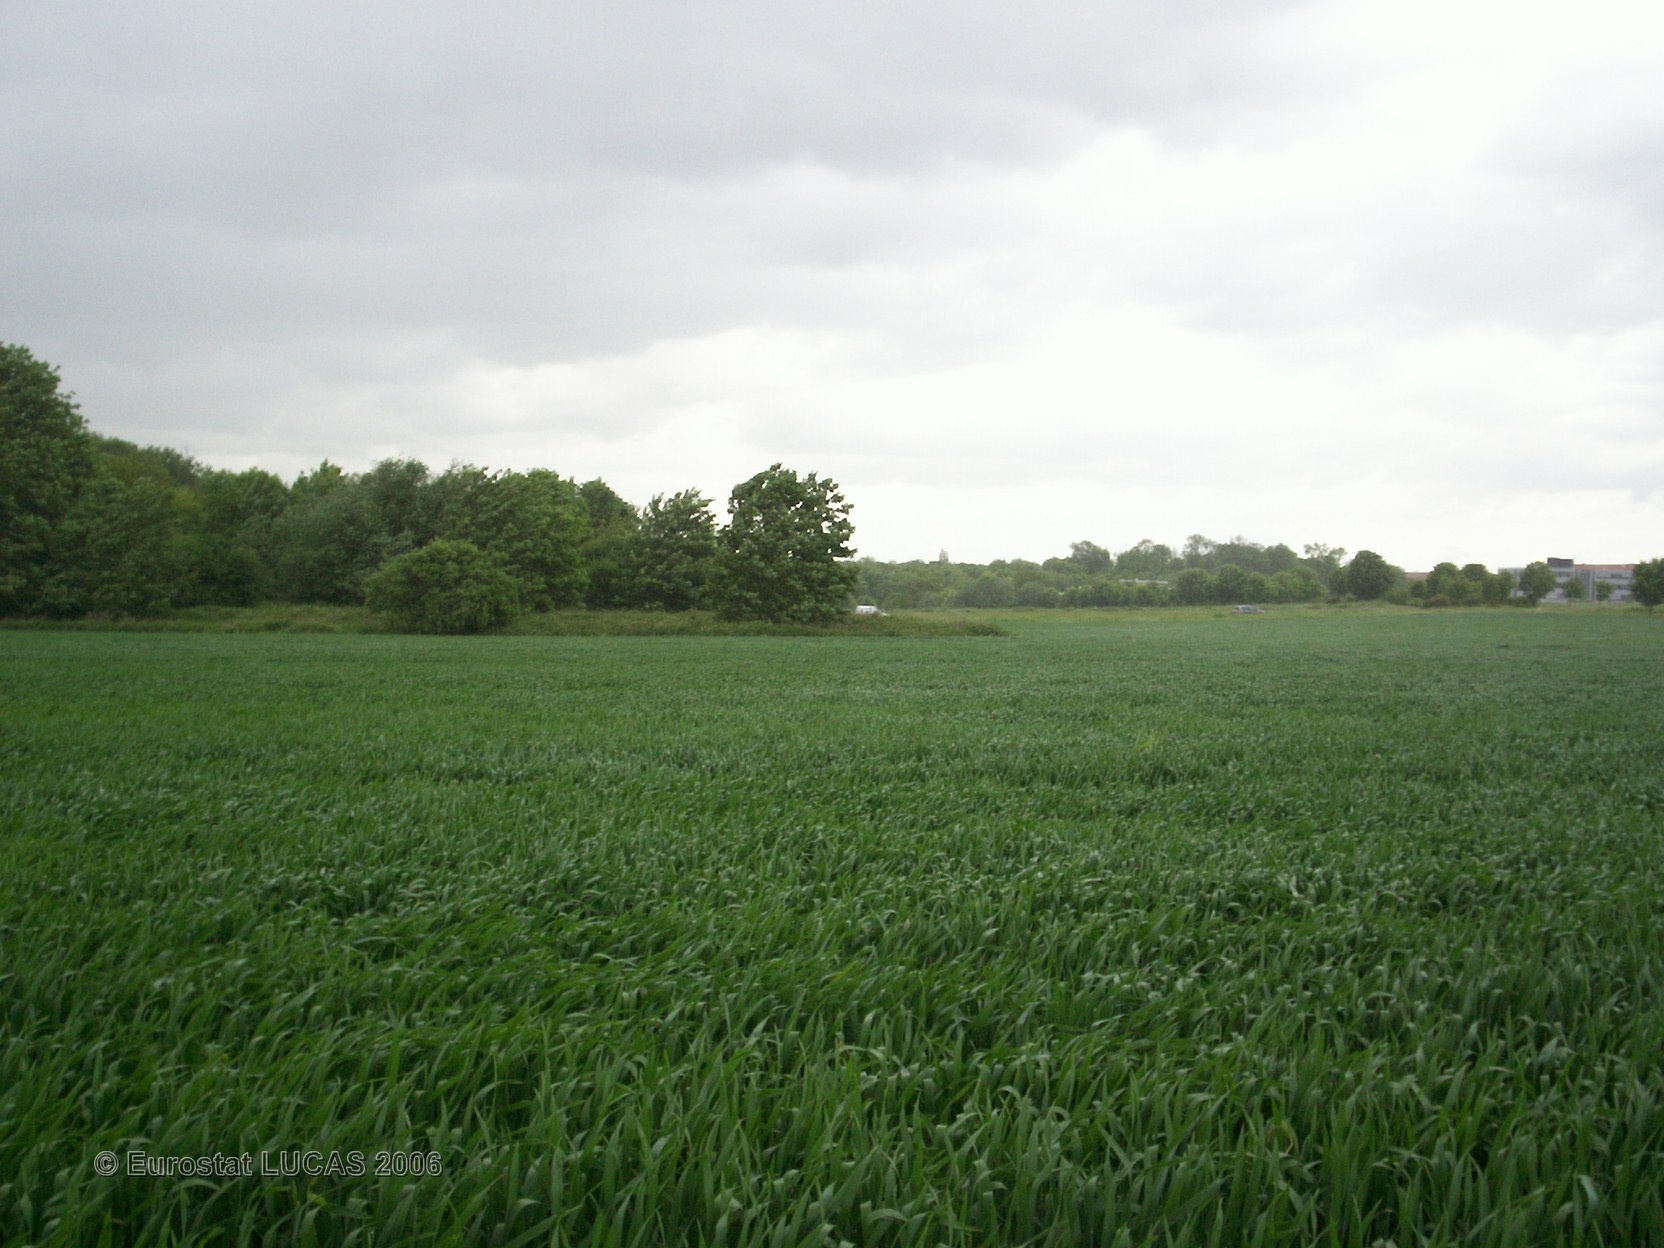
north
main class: Grassland
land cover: Grassland without tree/shrub cover
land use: Road transport
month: May
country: FR
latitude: 48.8305
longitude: 2.7018
